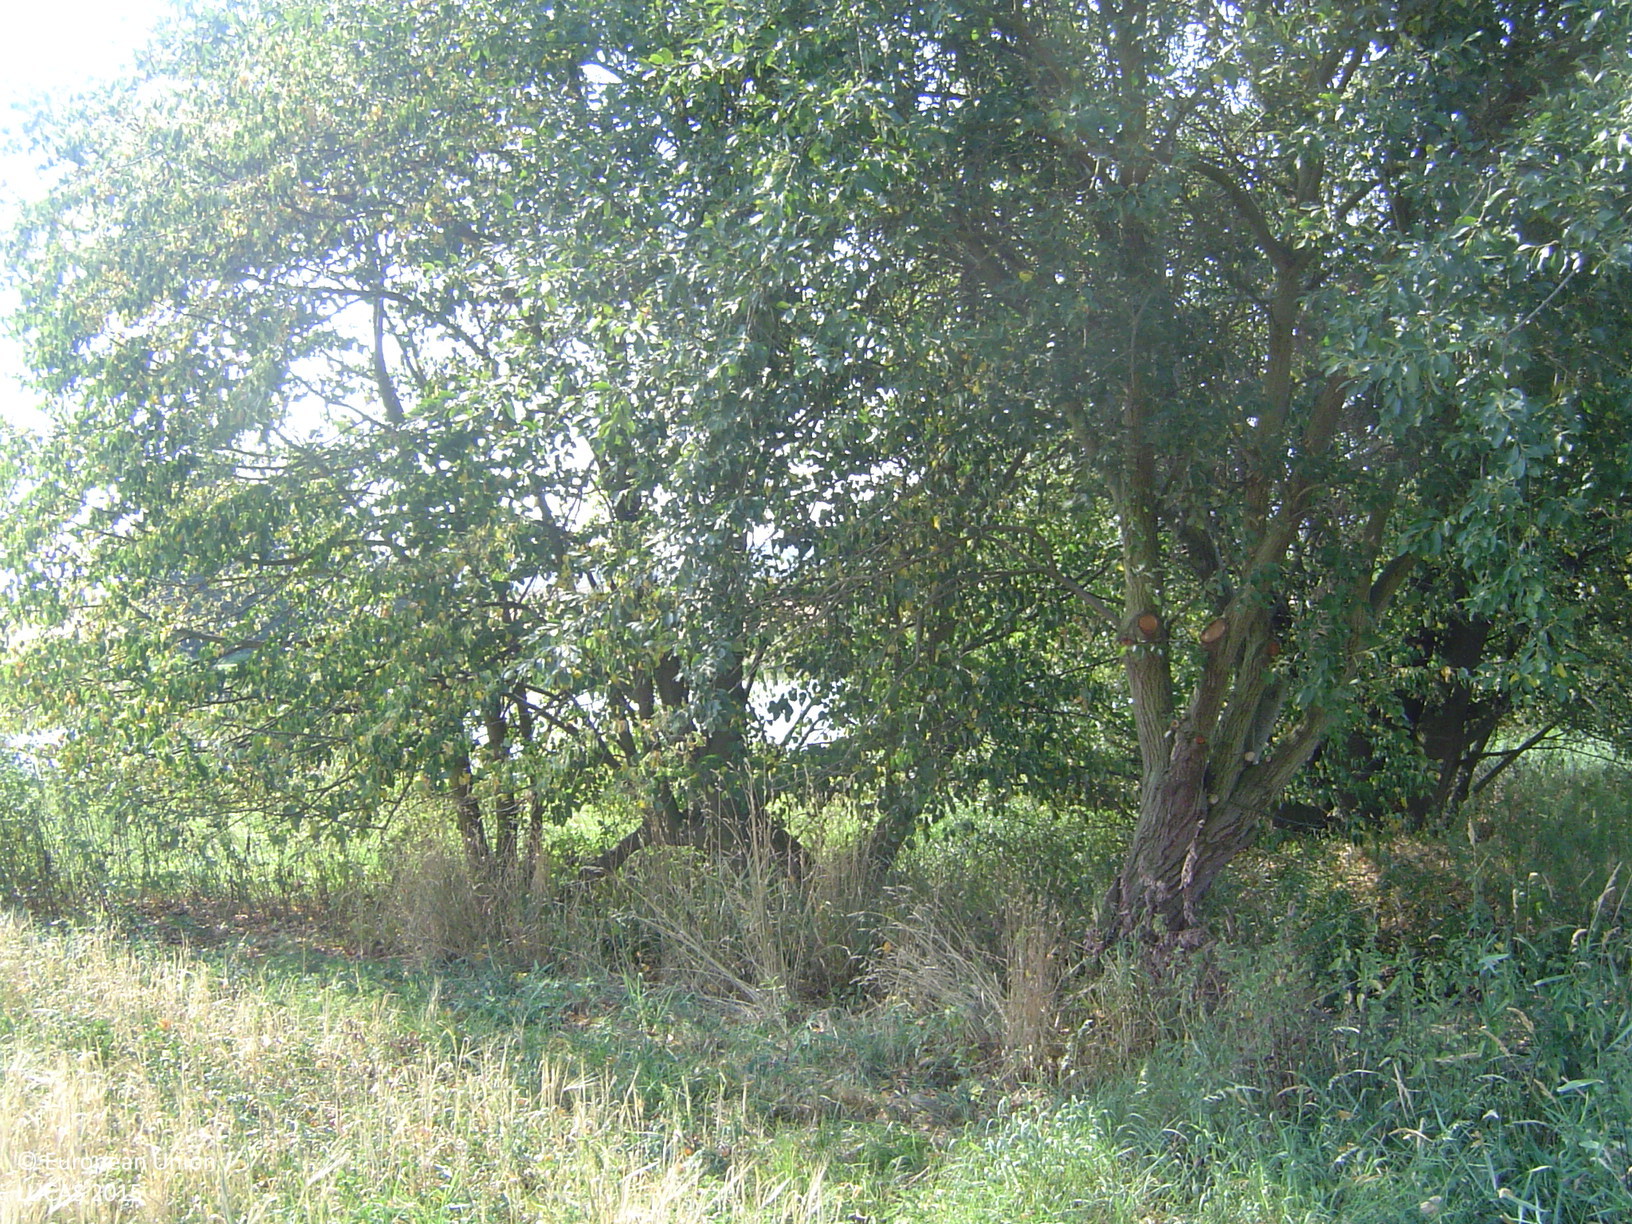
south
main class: Cropland
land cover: Barley
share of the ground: > 75 %
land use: Agriculture (excluding fallow land and kitchen gardens)
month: August
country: CZ
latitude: 49.6853
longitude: 14.3952
